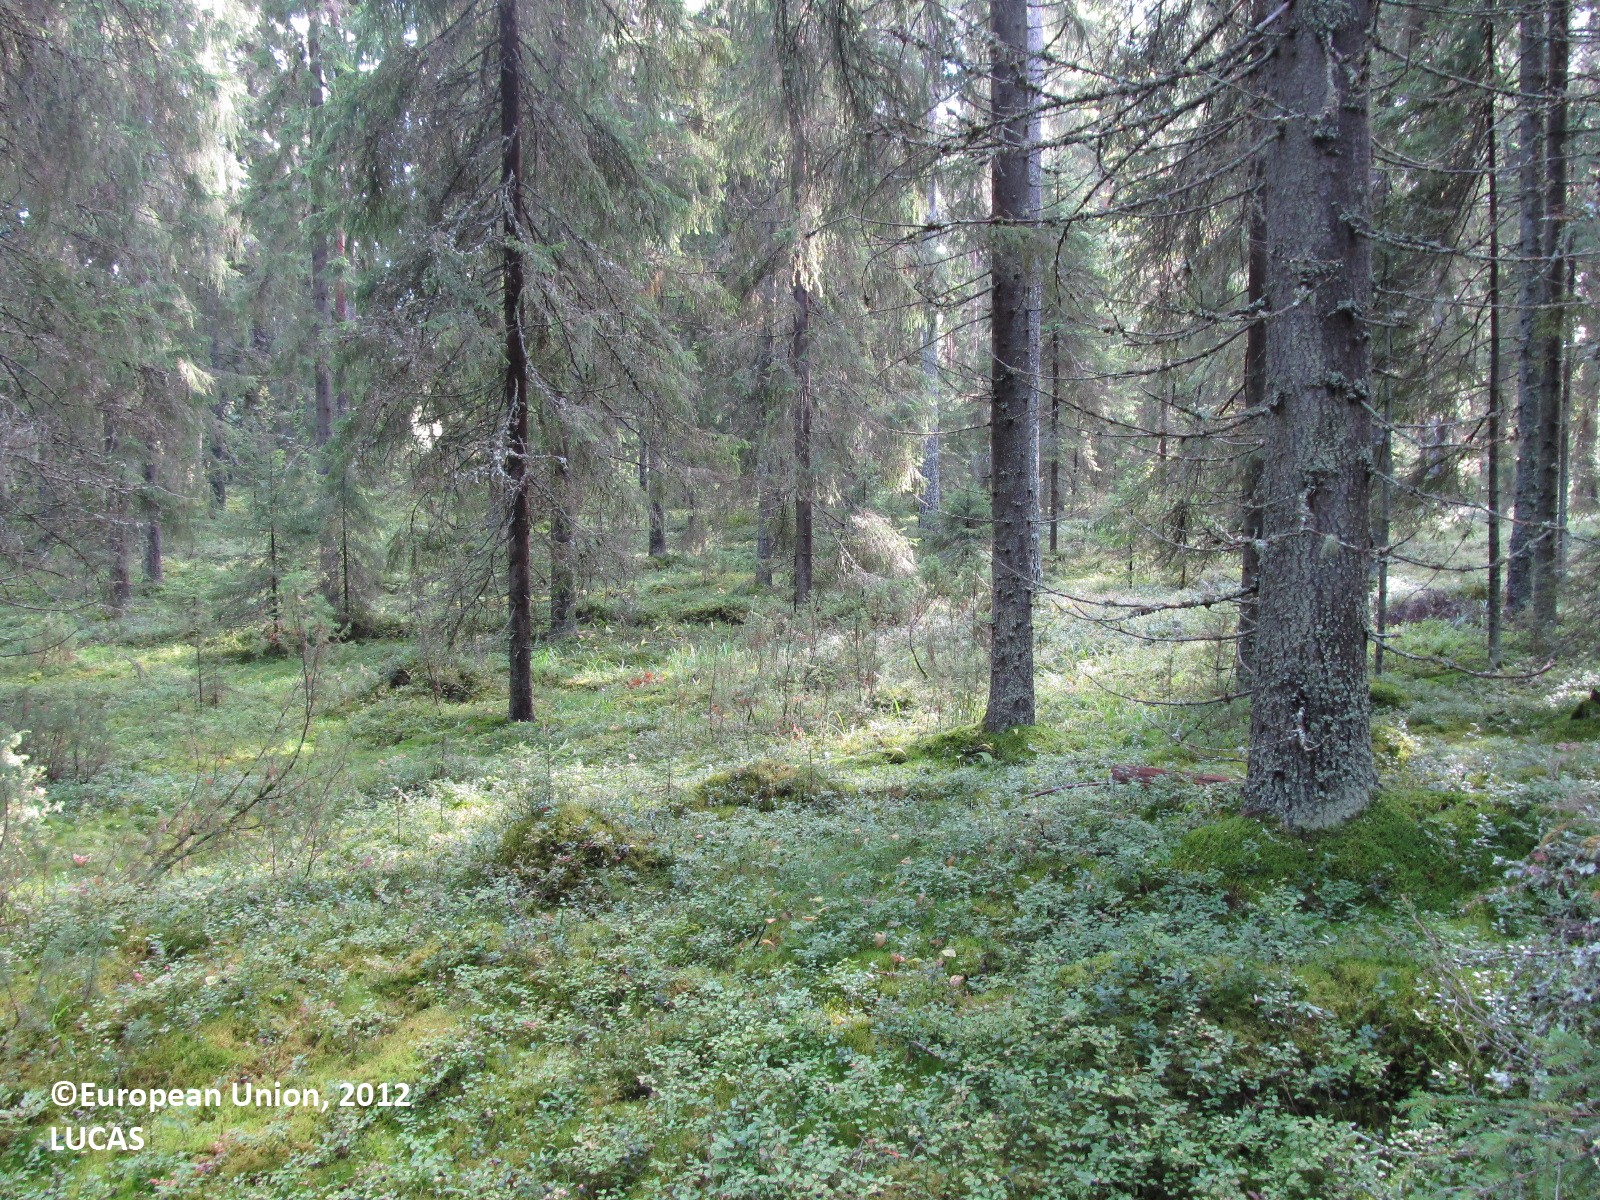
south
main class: Woodland
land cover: Spruce dominated coniferous woodland
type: boreal forest
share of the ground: 50 - 75 %
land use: Forestry
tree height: > 5 m
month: September
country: FI
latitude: 62.9097
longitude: 28.4404
